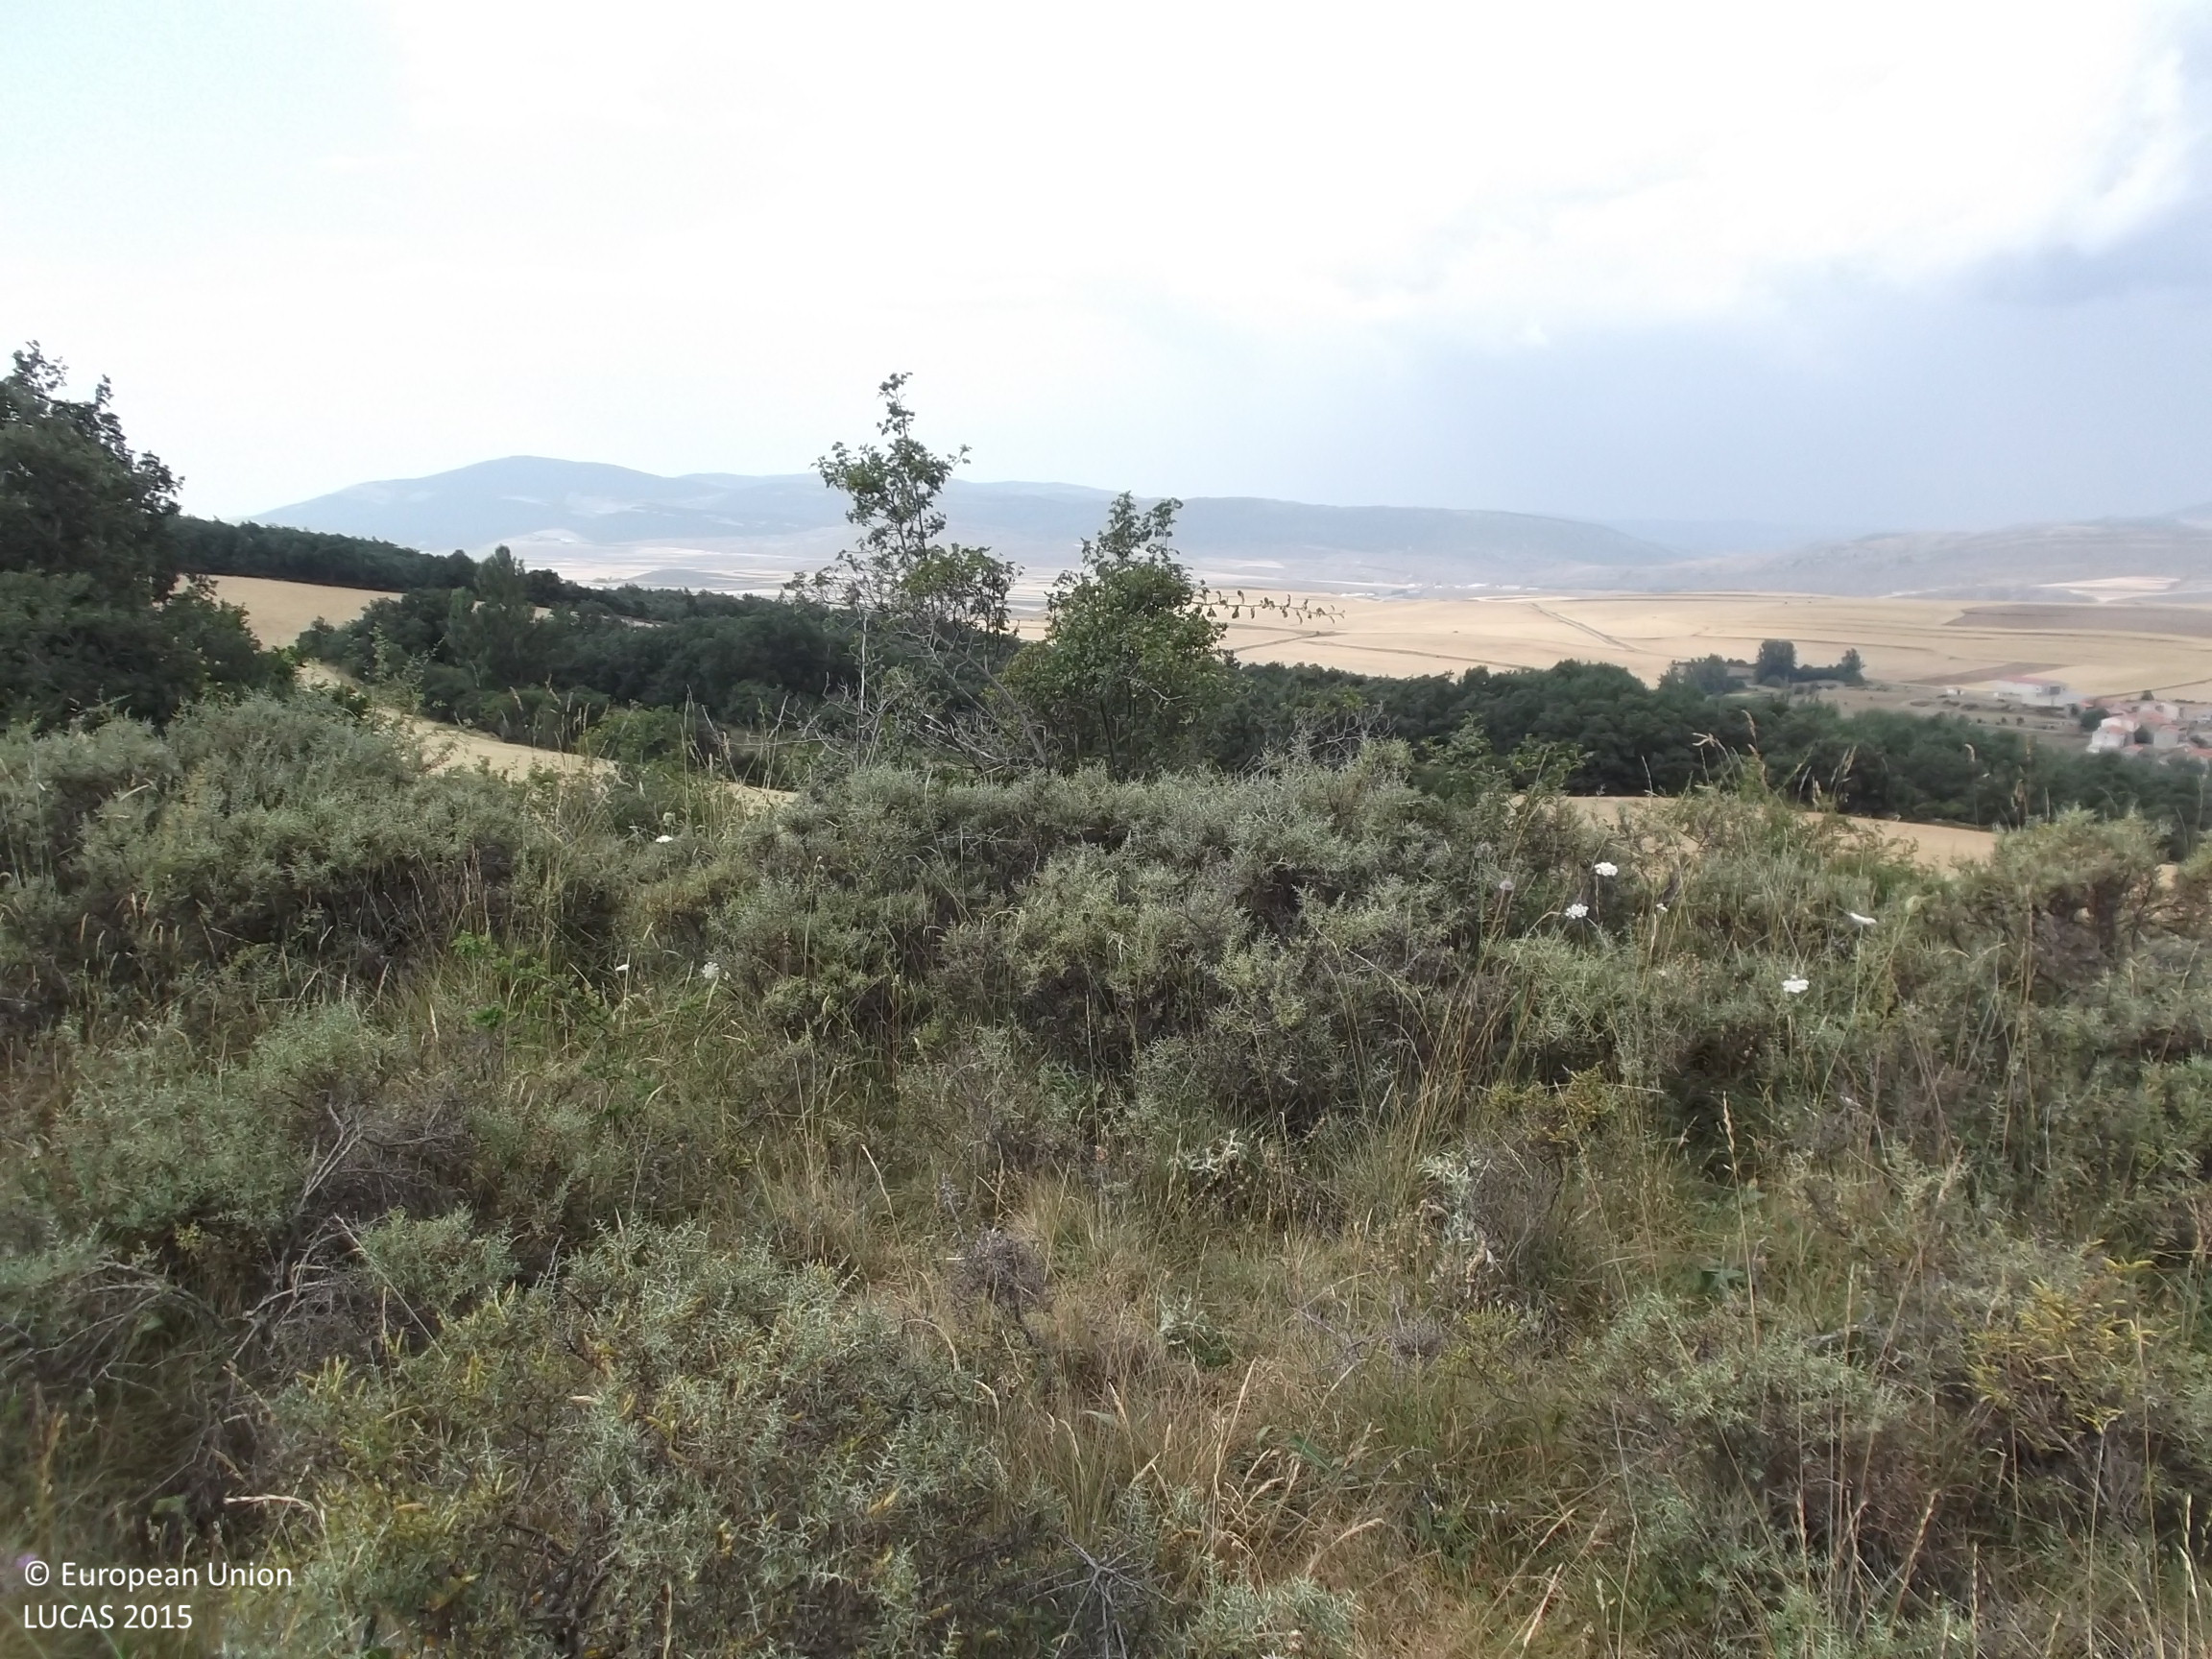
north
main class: Shrubland
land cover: Shrubland without tree cover
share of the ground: 25 - 50 %
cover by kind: shrubs 45 %, herbaceous plants 40 %, unconsolidated bare surface 10 %
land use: Abandoned areas
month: July
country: ES
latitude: 41.9817
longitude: -2.2397
